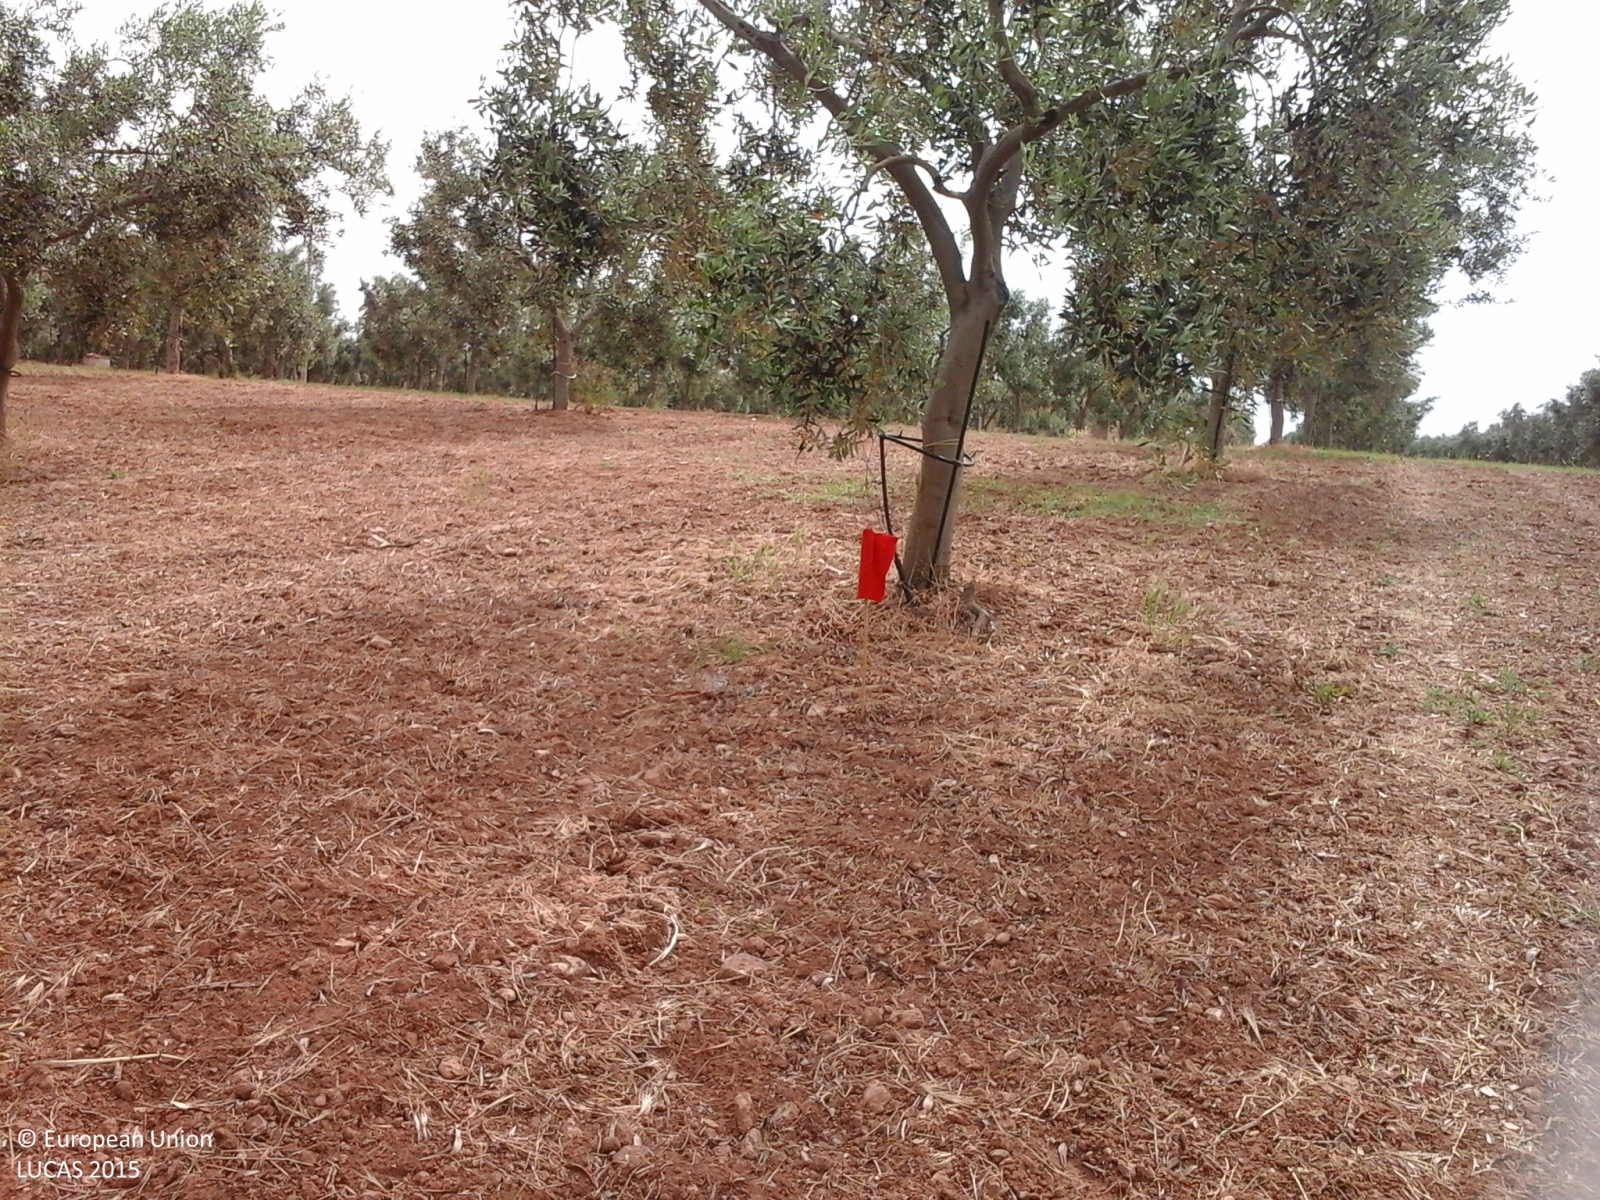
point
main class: Cropland
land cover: Olive groves
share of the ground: 10 - 25 %
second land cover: Other bare soil
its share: > 75 %
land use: Agriculture (excluding fallow land and kitchen gardens)
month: May
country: IT
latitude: 37.6343
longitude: 12.7778
